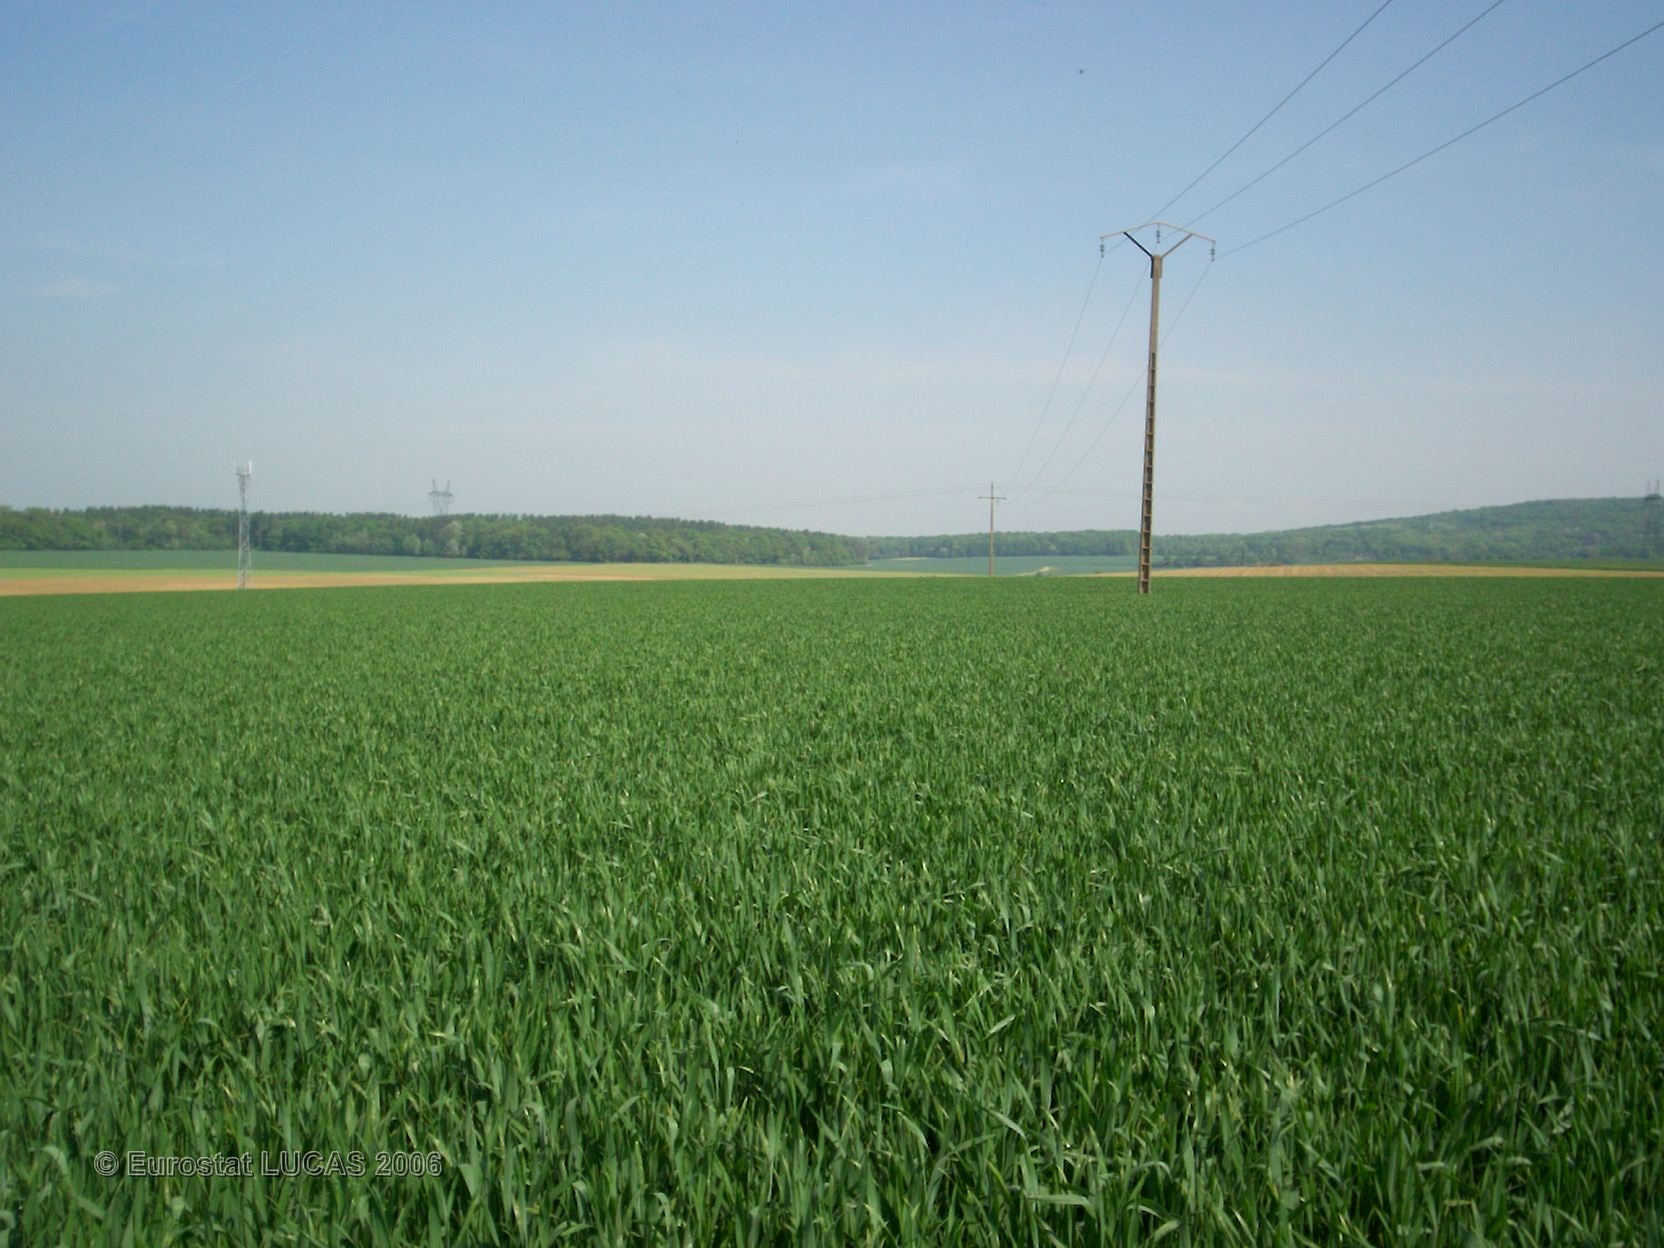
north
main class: Cropland
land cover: Common wheat
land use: Agriculture (excluding fallow land and kitchen gardens)
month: May
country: FR
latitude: 49.0130
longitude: 2.7297
